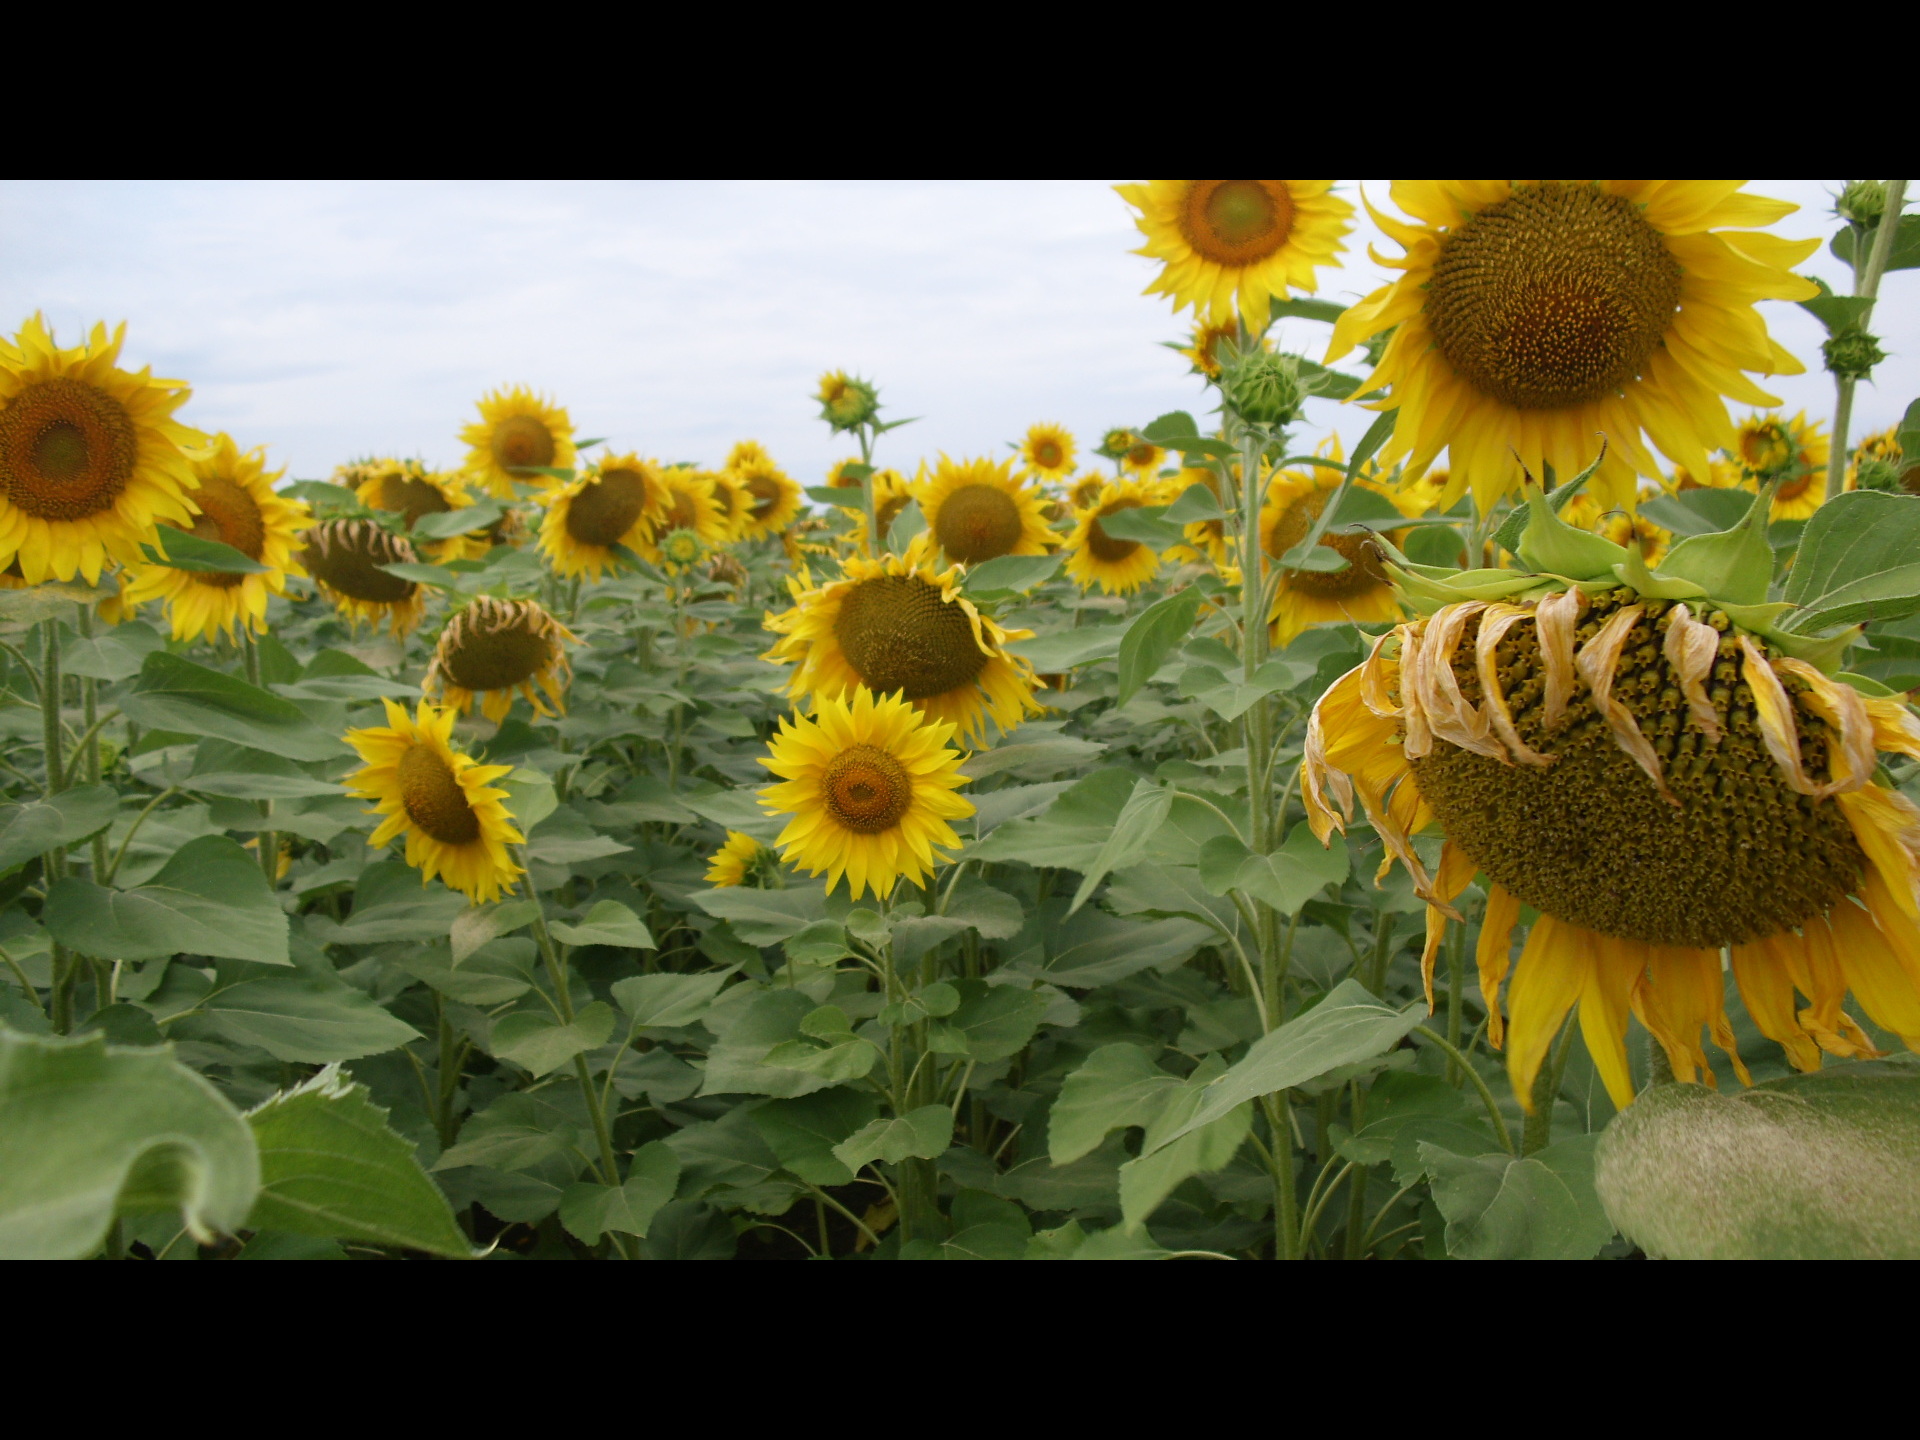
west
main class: Cropland
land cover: Sunflower
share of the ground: > 75 %
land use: Agriculture (excluding fallow land and kitchen gardens)
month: July
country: BG
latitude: 43.9333
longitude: 22.8317
